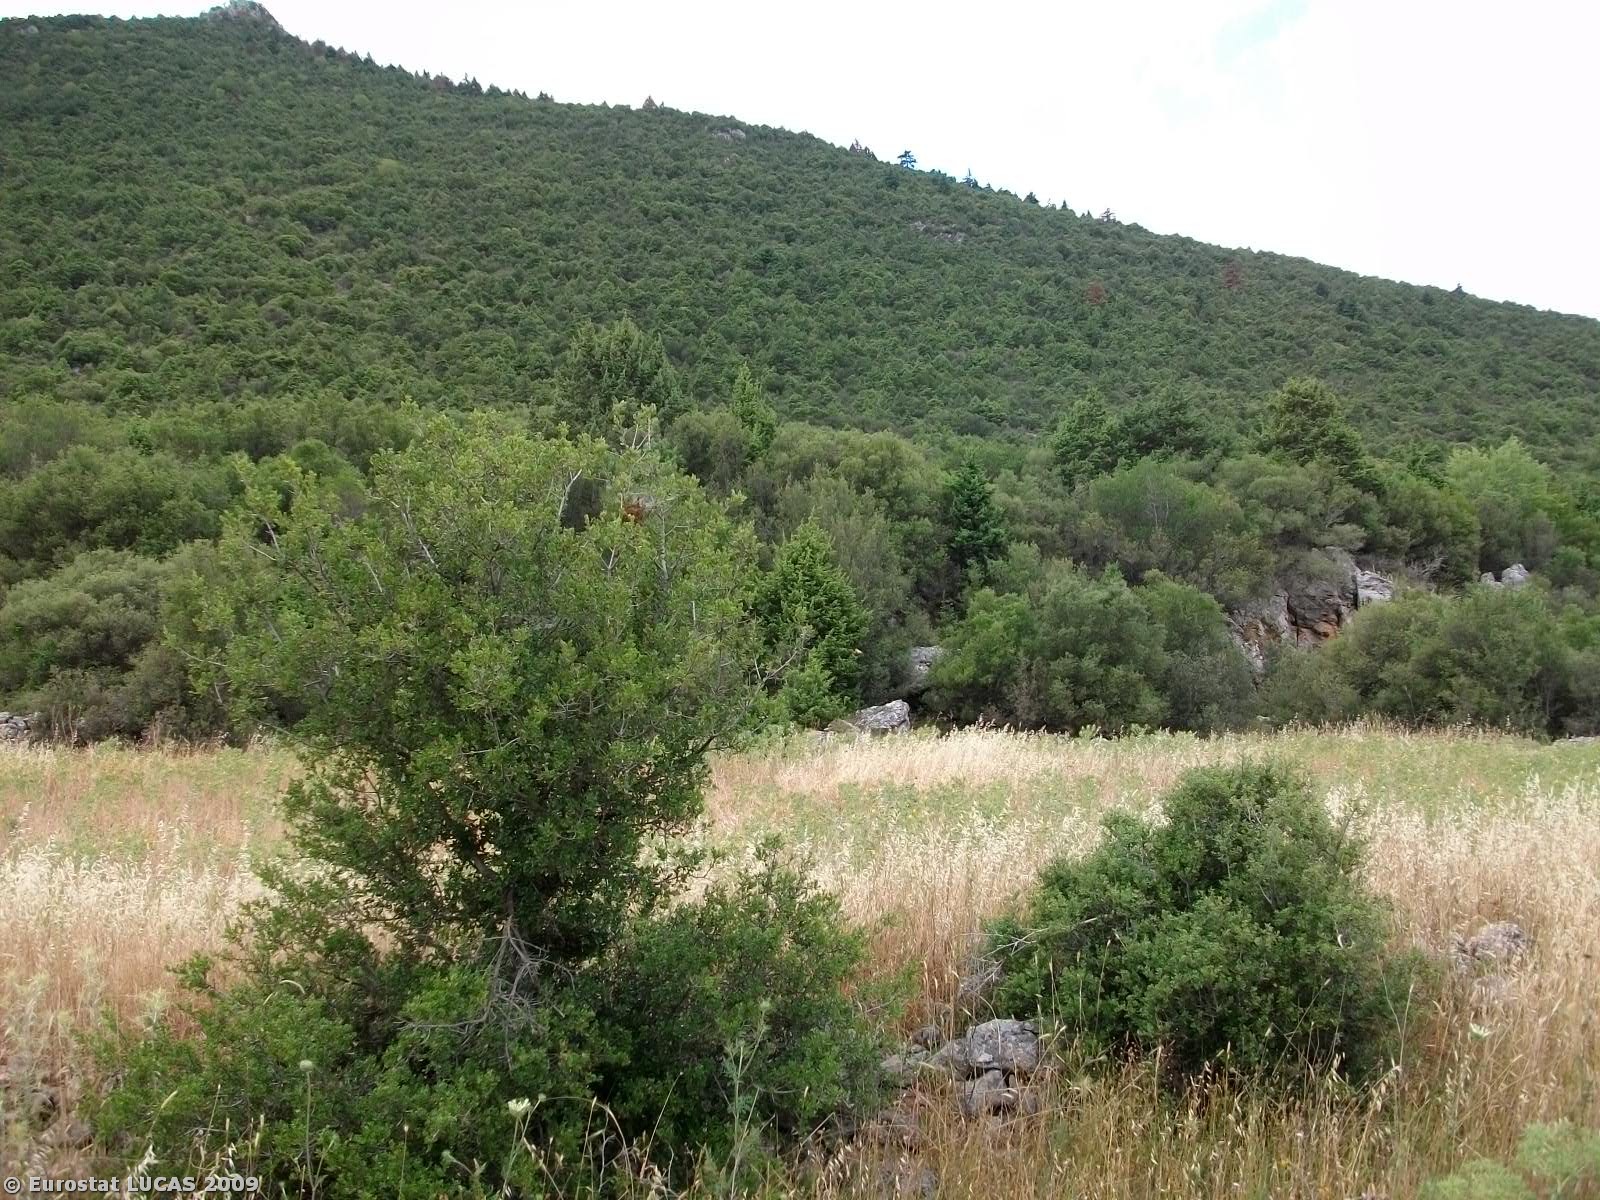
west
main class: Grassland
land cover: Grassland with sparse tree/shrub cover
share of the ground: > 75 %
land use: Unused
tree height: < 5 m
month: June
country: GR
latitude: 37.7848
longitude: 22.4680
